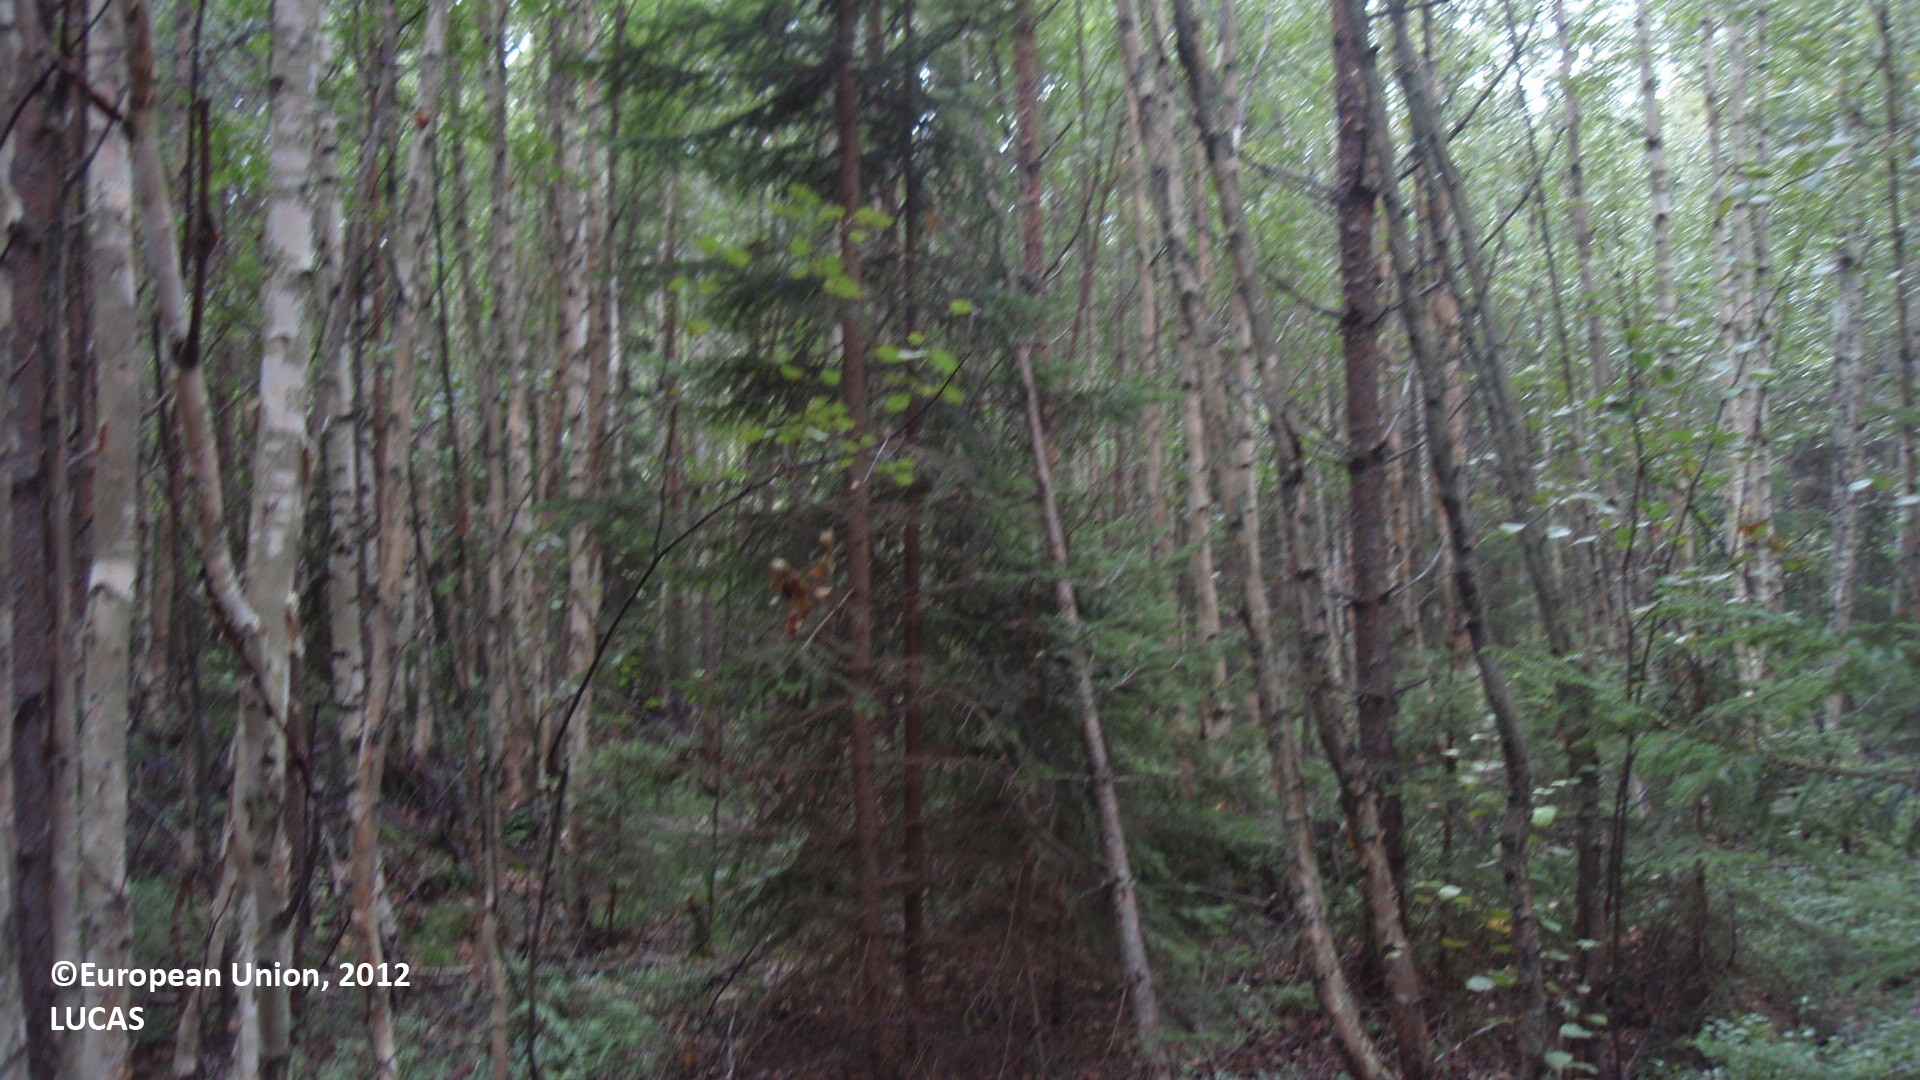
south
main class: Woodland
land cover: Pine dominated mixed woodland
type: boreal forest
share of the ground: > 75 %
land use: Forestry
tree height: > 5 m
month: August
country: FI
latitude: 60.9328
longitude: 27.5858
